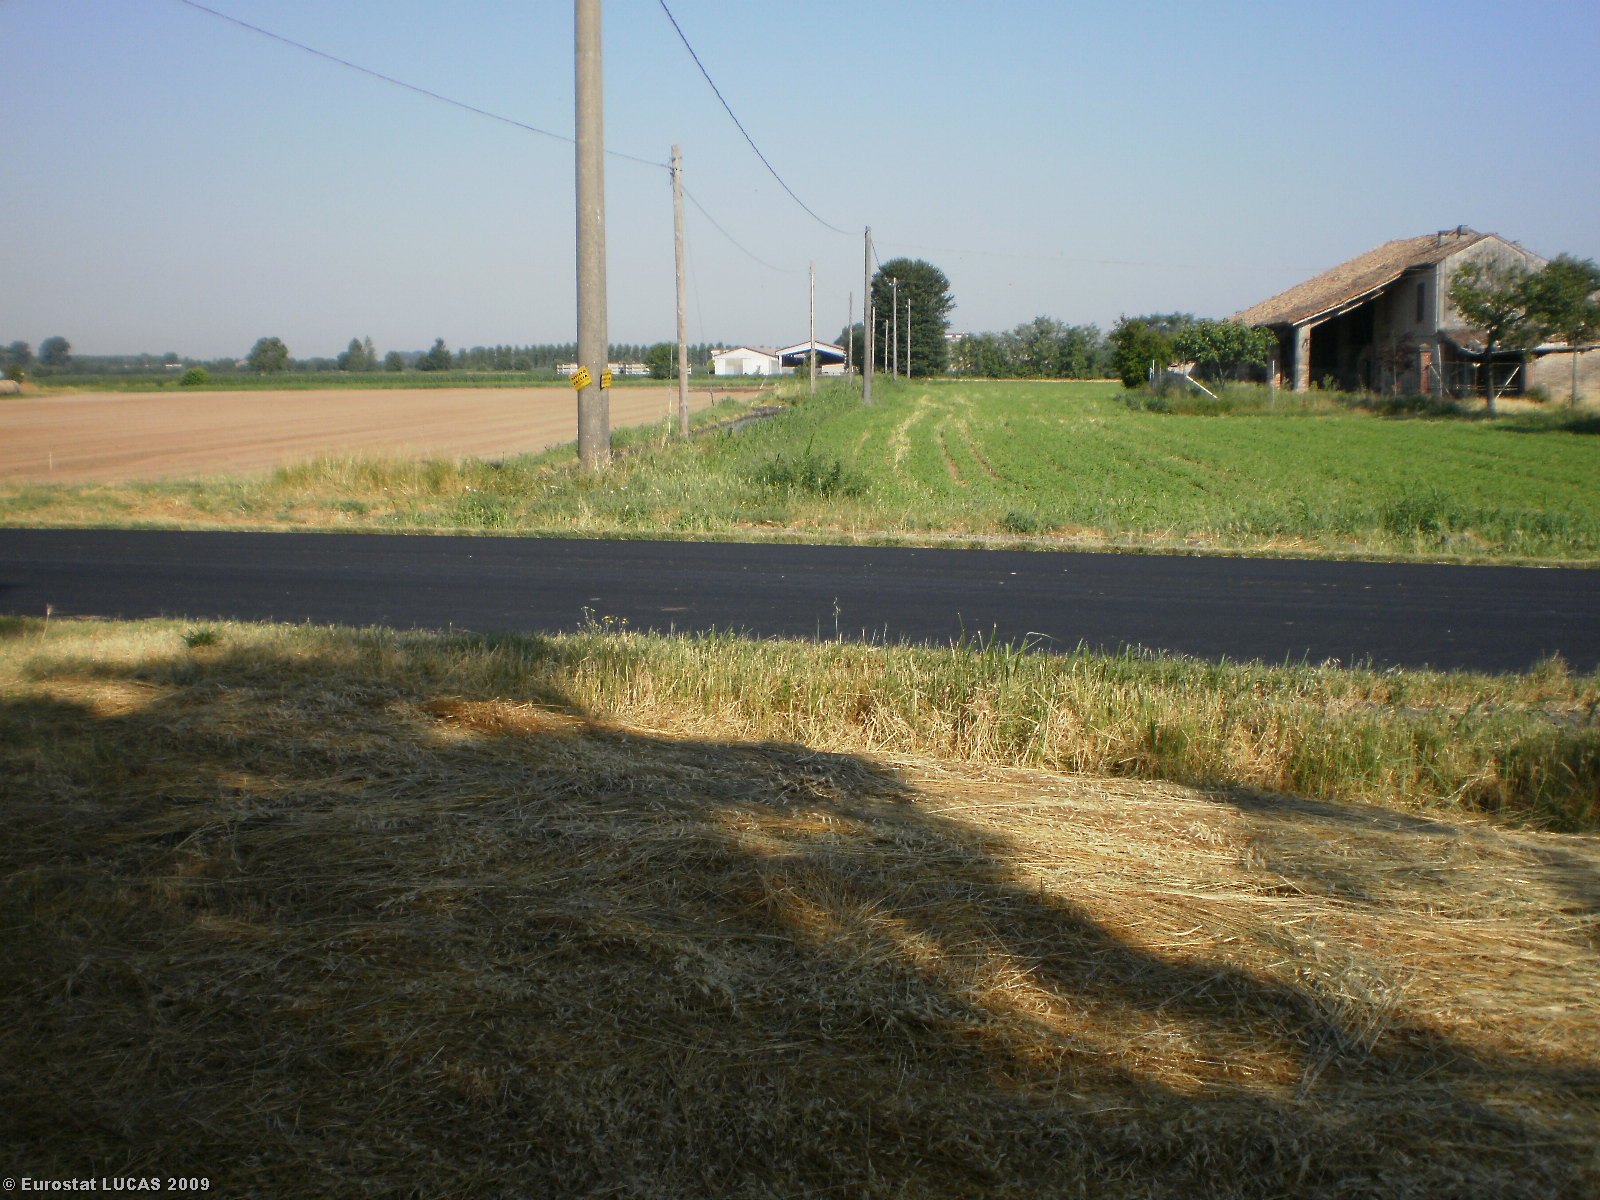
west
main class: Grassland
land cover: Grassland with sparse tree/shrub cover
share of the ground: > 75 %
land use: Agriculture (excluding fallow land and kitchen gardens)
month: June
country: IT
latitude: 45.2337
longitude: 10.2670
